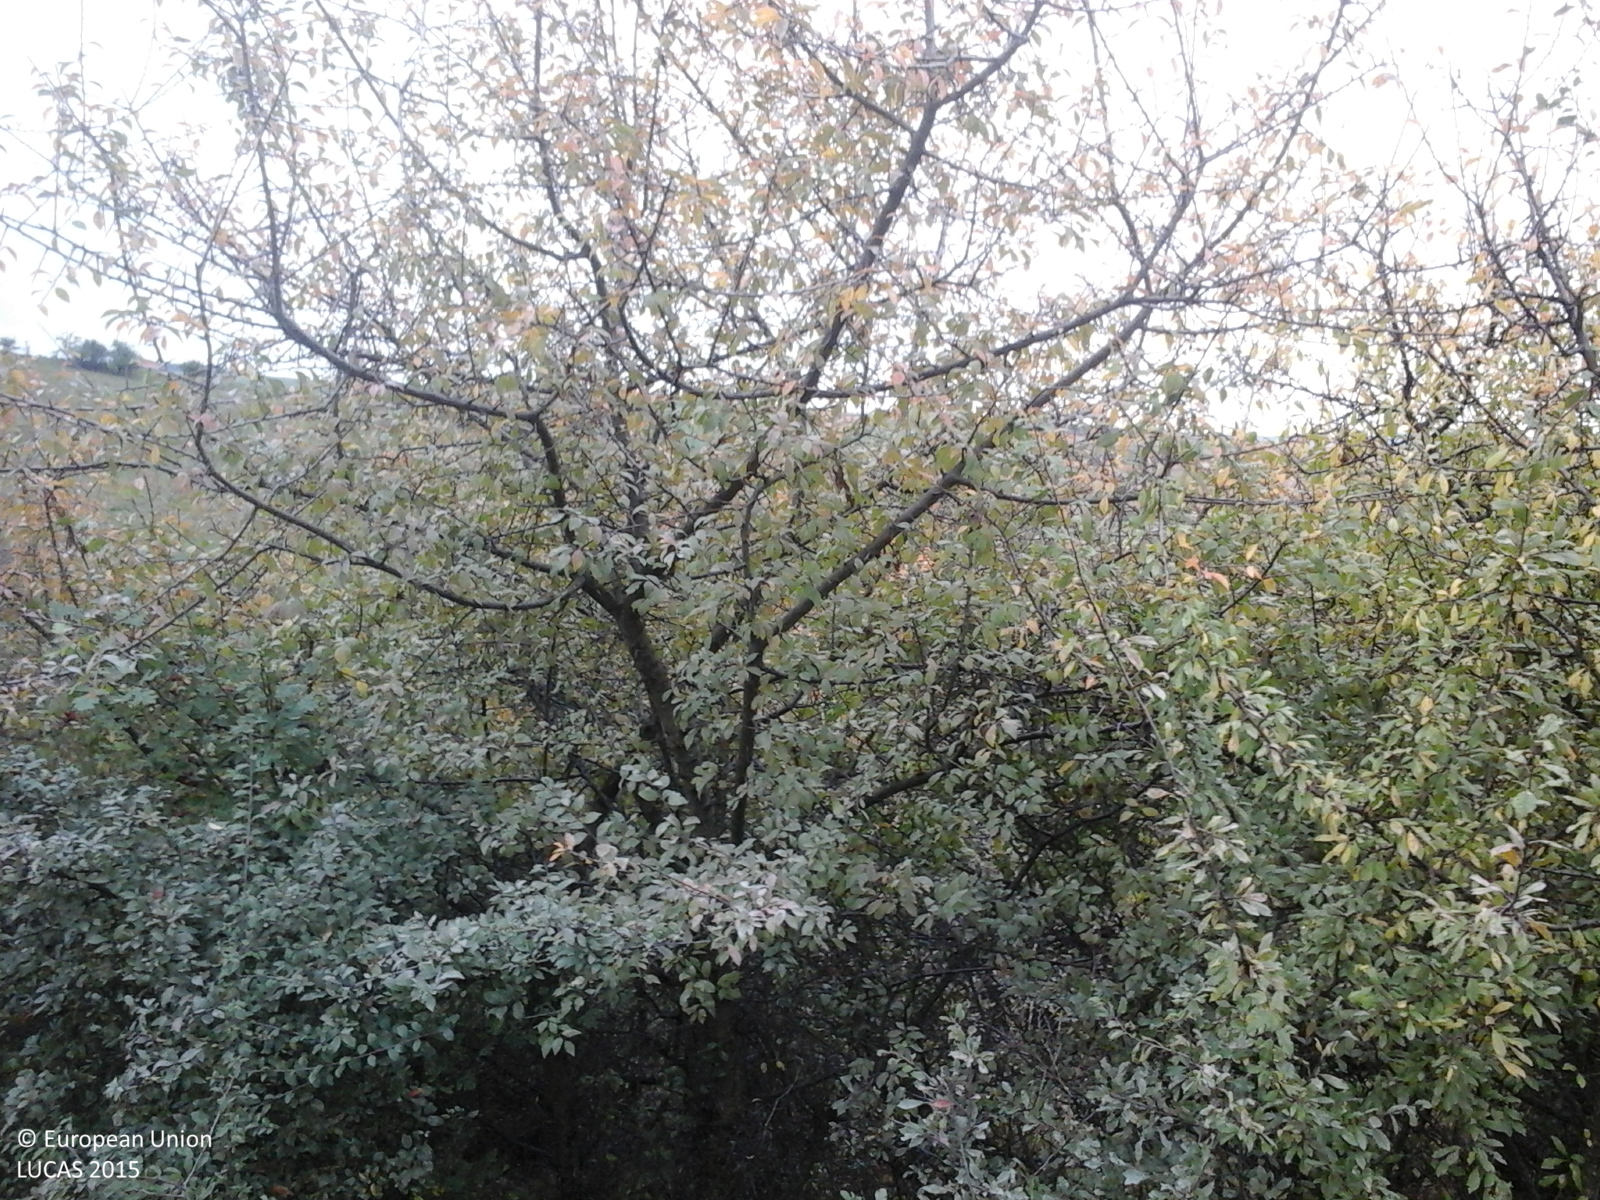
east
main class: Shrubland
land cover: Shrubland without tree cover
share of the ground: > 75 %
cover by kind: herbaceous plants 90 %, shrubs 10 %
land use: Semi-natural and natural areas not in use
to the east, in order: Shrubland without tree cover; Grassland without tree/shrub cover; Shrubland without tree cover; Grassland without tree/shrub cover; Shrubland without tree cover
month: October
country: RO
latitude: 45.8646
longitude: 24.1282
